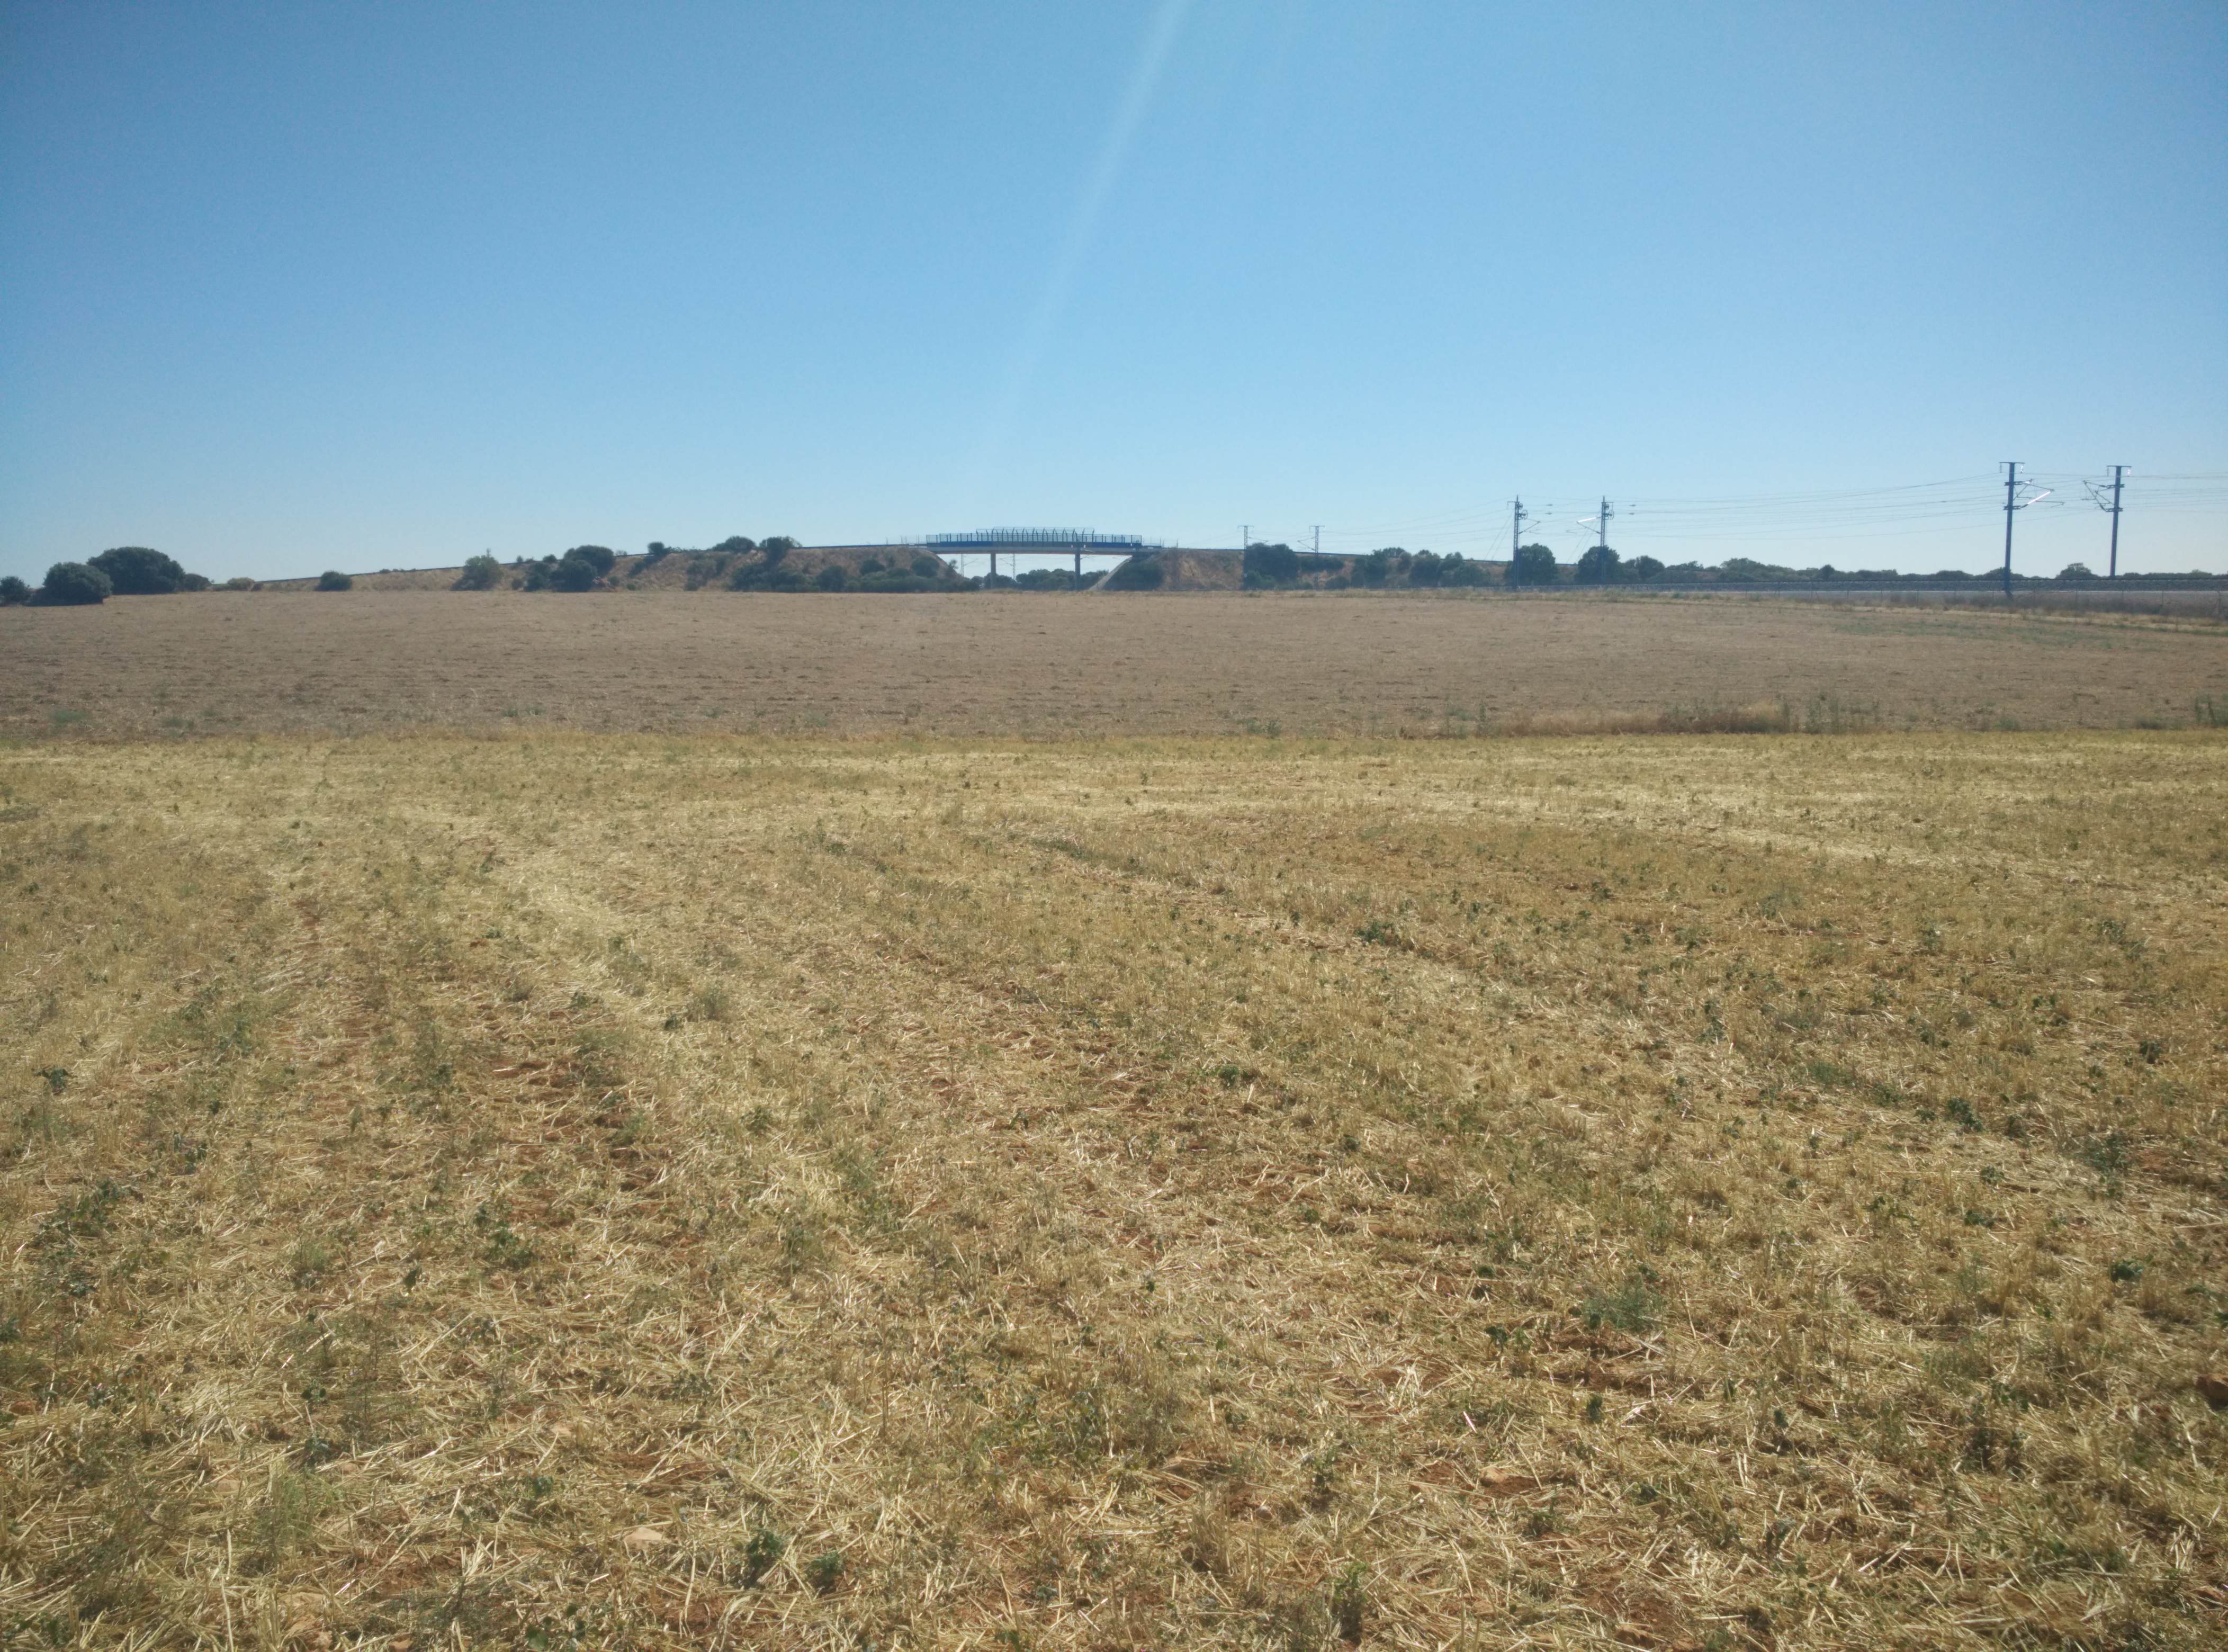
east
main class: Cropland
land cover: Barley
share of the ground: < 10 %
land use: Agriculture (excluding fallow land and kitchen gardens)
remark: Harvested field
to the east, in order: Barley; Dry pulses; Tracks
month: July
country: ES
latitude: 40.8446
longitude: -2.8536
